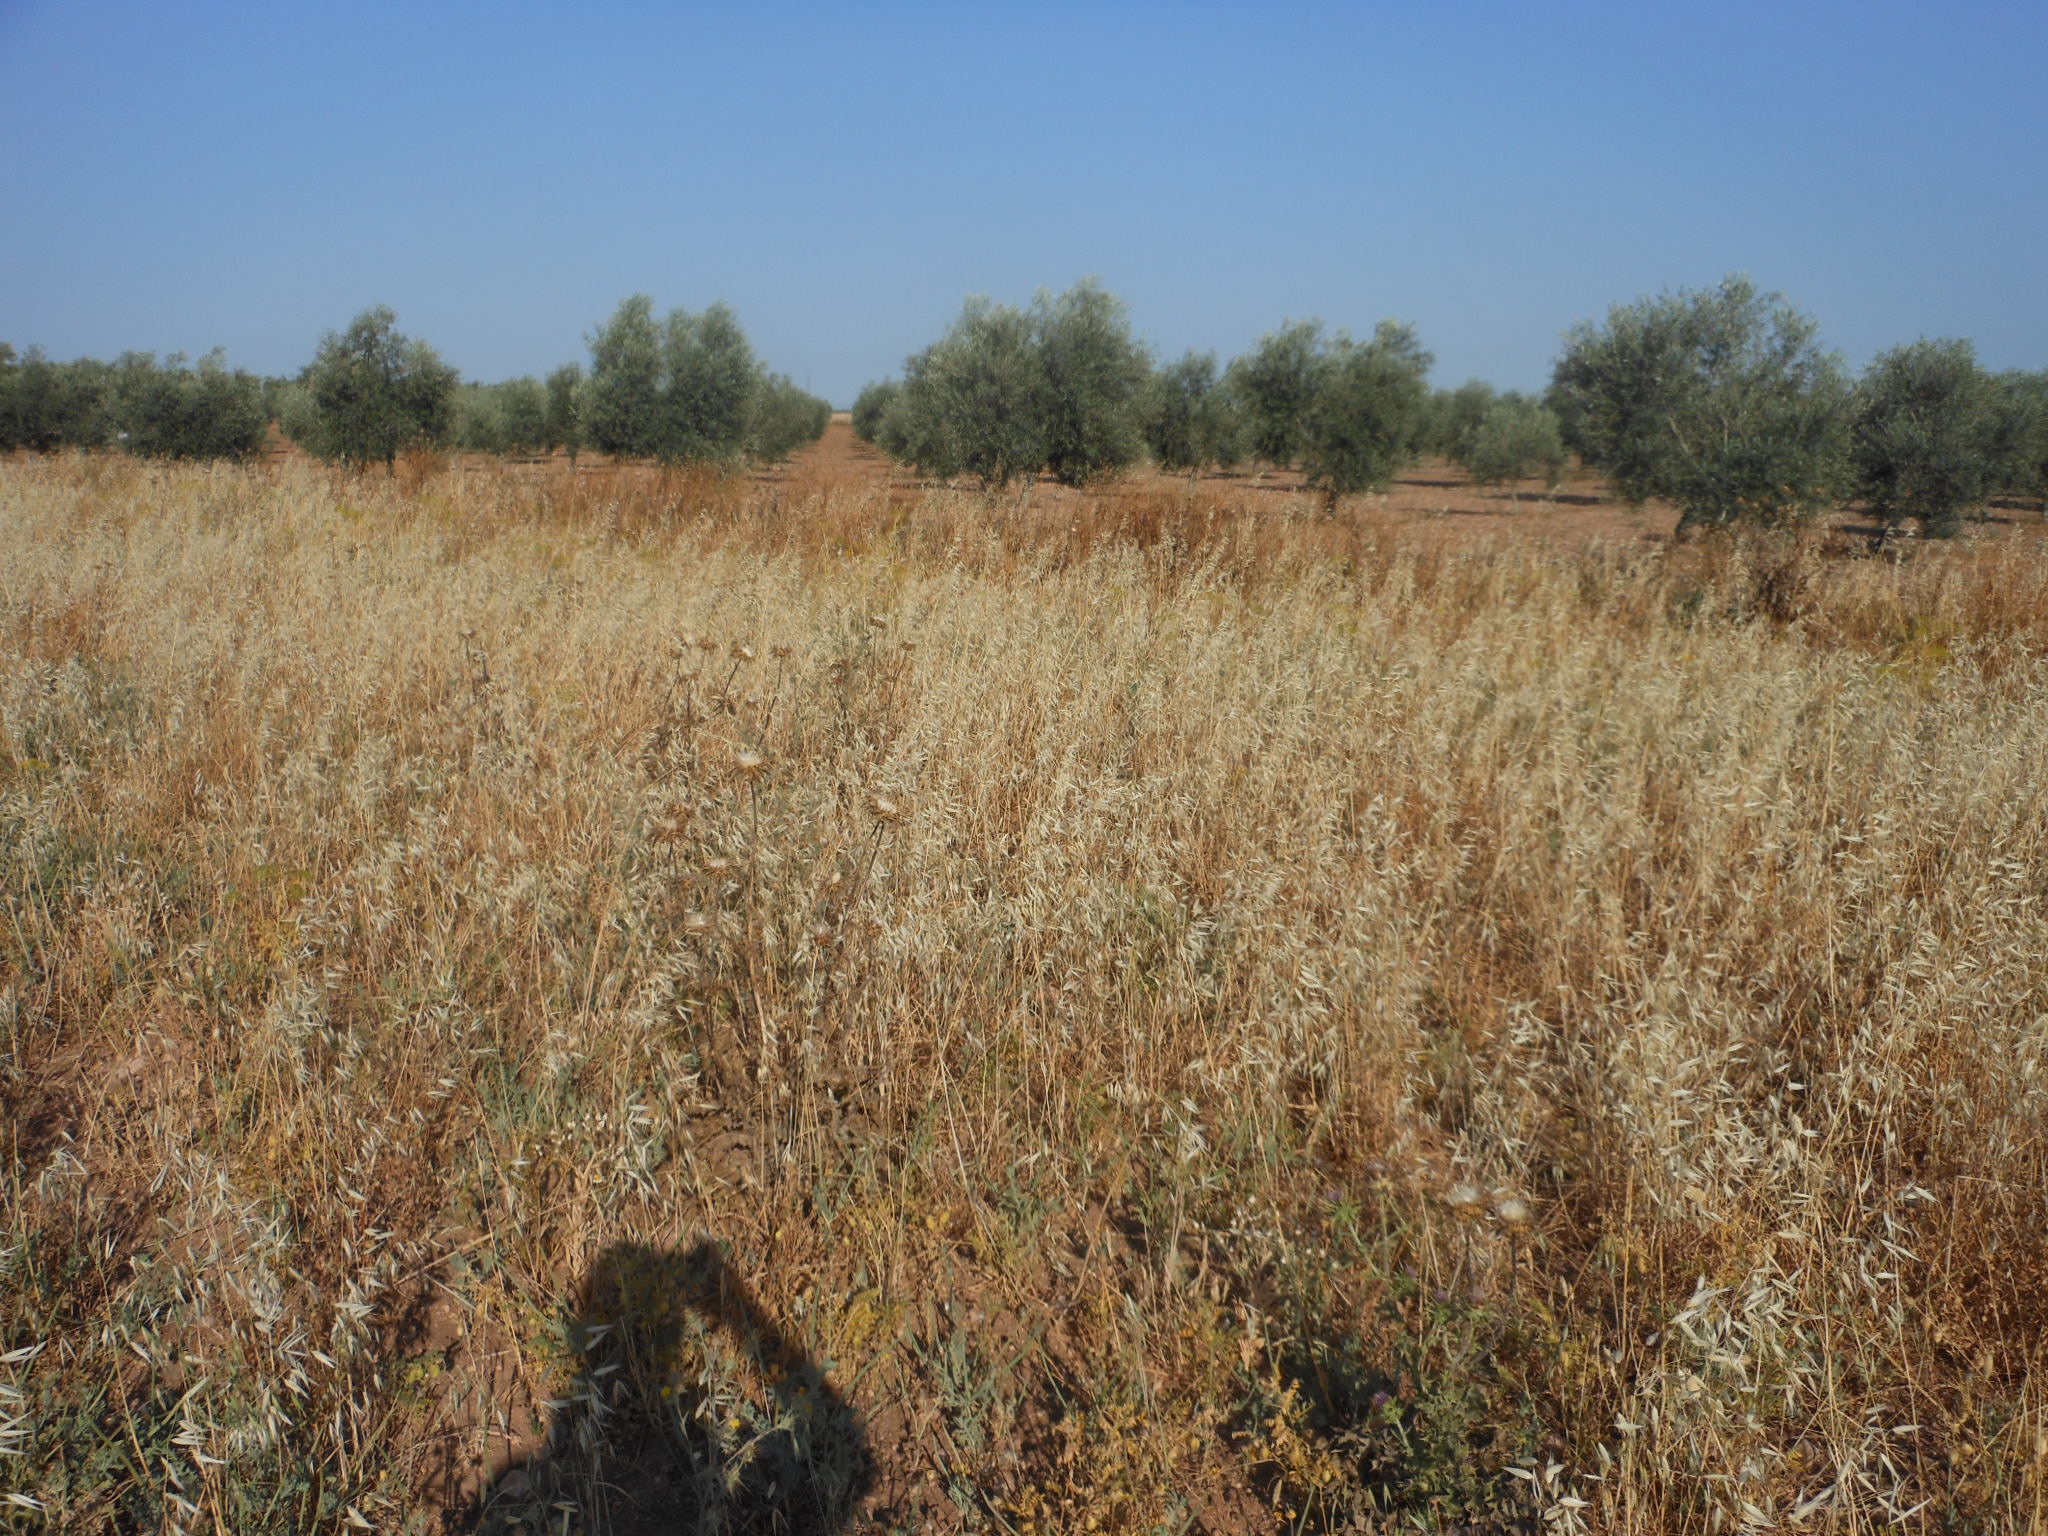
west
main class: Grassland
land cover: Spontaneously vegetated surfaces
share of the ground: 50 - 75 %
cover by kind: herbaceous plants 70 %, unconsolidated bare surface 30 %
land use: Fallow land
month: June
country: ES
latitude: 37.2658
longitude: -5.1300
